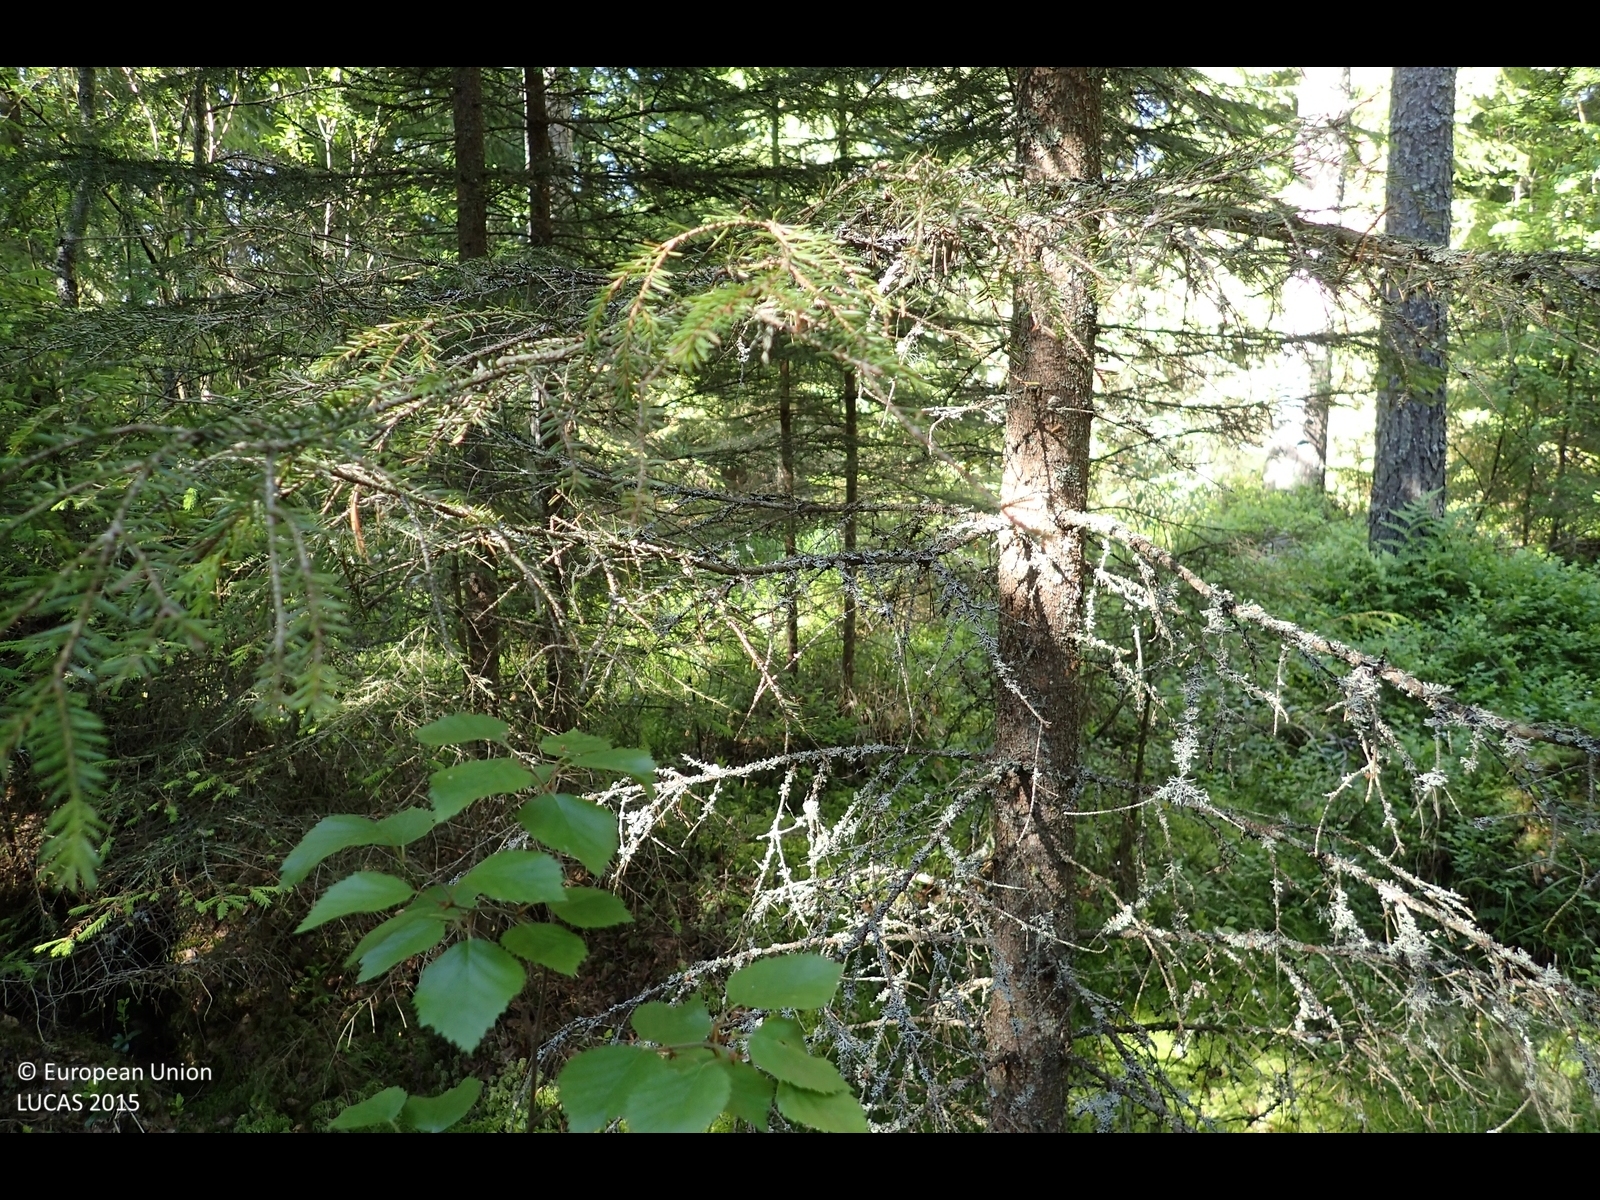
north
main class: Woodland
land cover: Other mixed woodland
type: boreal forest
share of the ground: > 75 %
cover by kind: coniferous forest trees 60 %, broadleaved forest trees 20 %, shrubs 10 %, lichens and mosses 10 %
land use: Forestry
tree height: > 5 m
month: July
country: FI
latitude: 62.6130
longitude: 21.6778
